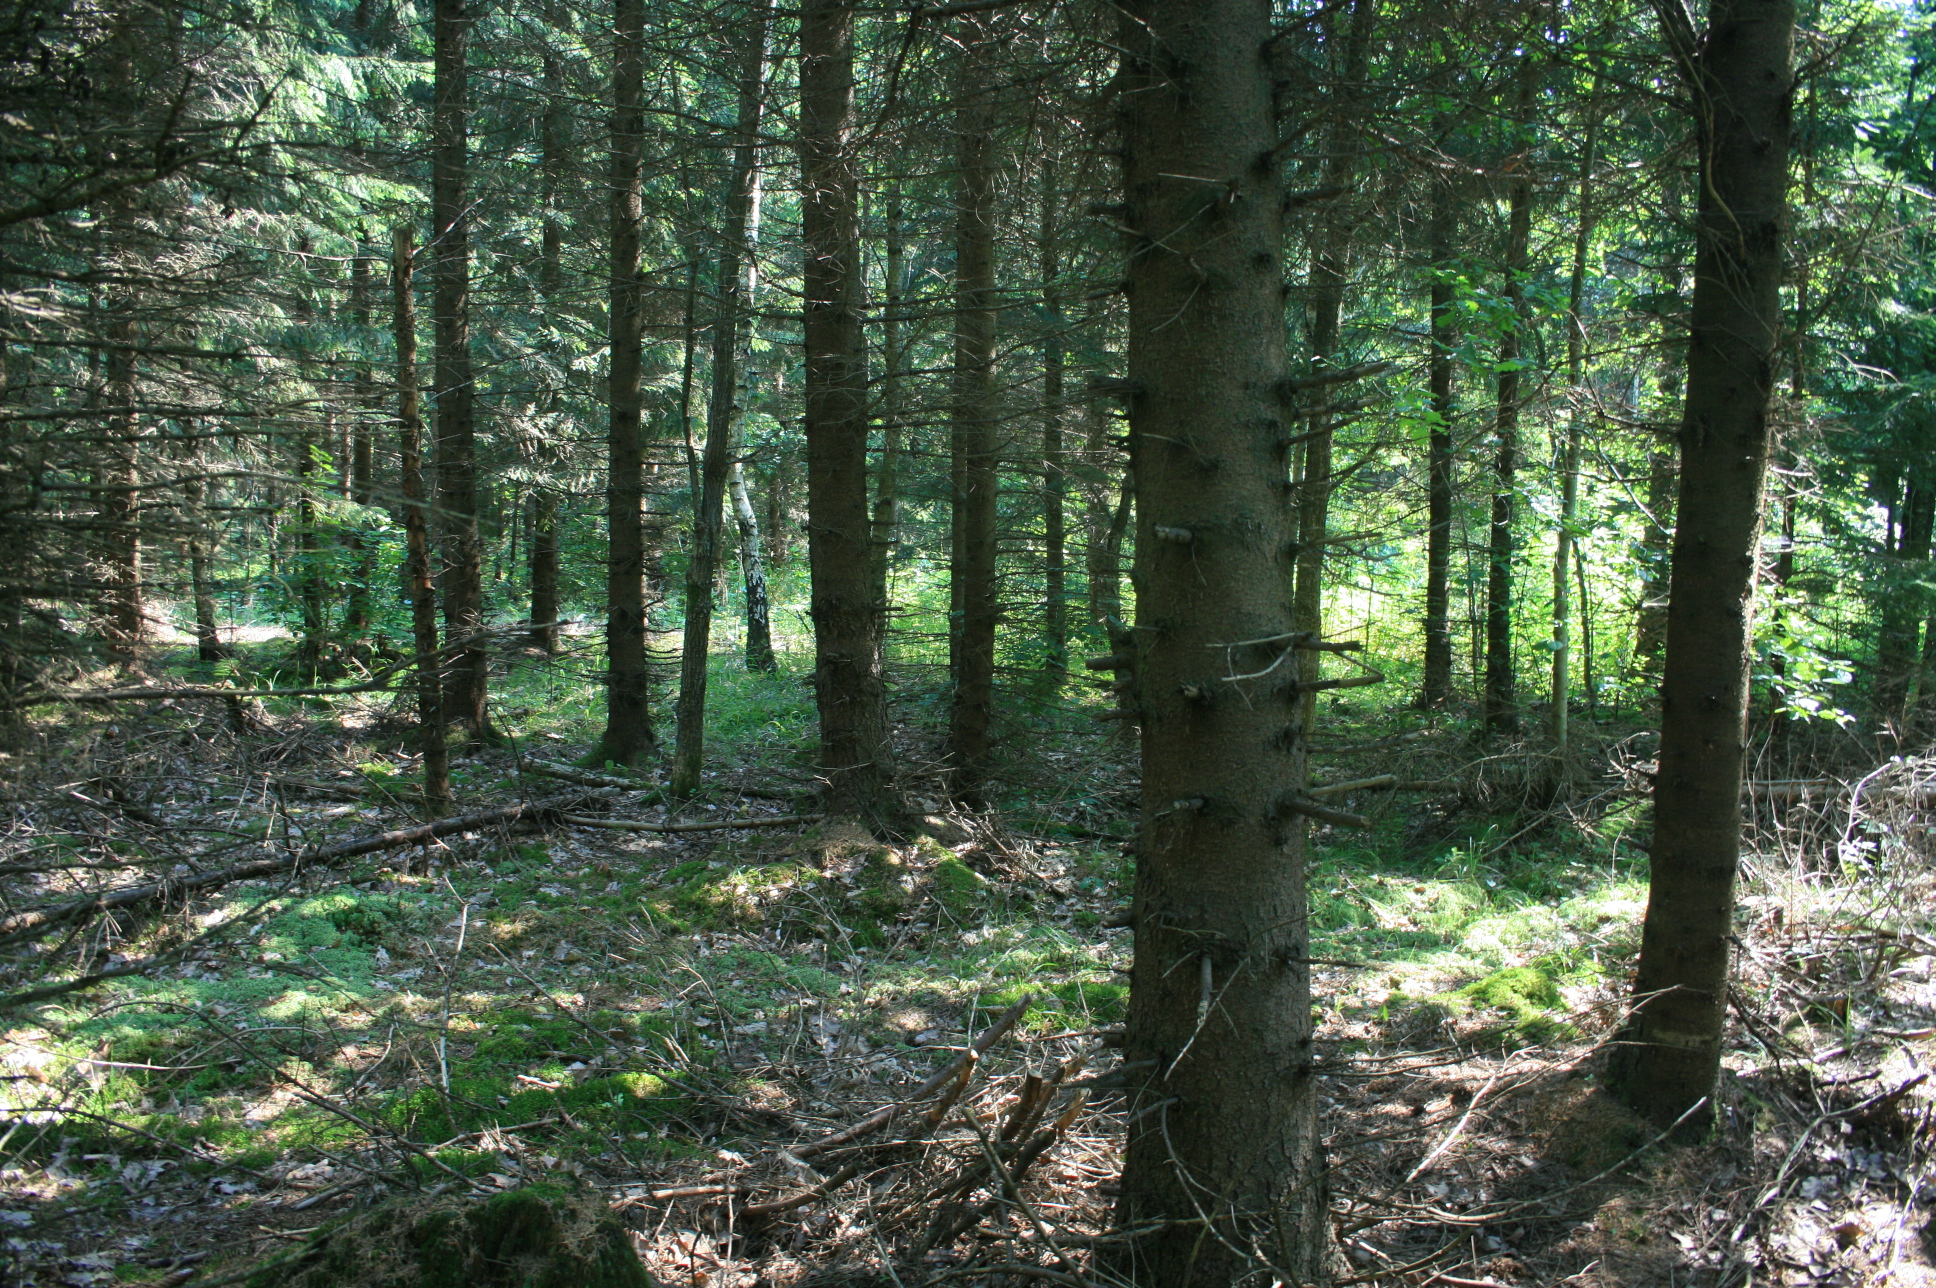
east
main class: Woodland
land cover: Spruce dominated mixed woodland
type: hemiboreal forest and nemoral coniferous forest and mixed broadleaved-coniferous forest
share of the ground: > 75 %
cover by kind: coniferous forest trees 60 %, broadleaved forest trees 25 %, shrubs 5 %, herbaceous plants 5 %, lichens and mosses 5 %
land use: Forestry
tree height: > 5 m
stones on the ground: < 10 %
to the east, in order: Spruce dominated mixed woodland; Broadleaved woodland; Other mixed woodland
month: August
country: LT
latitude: 55.5506
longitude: 21.7955
